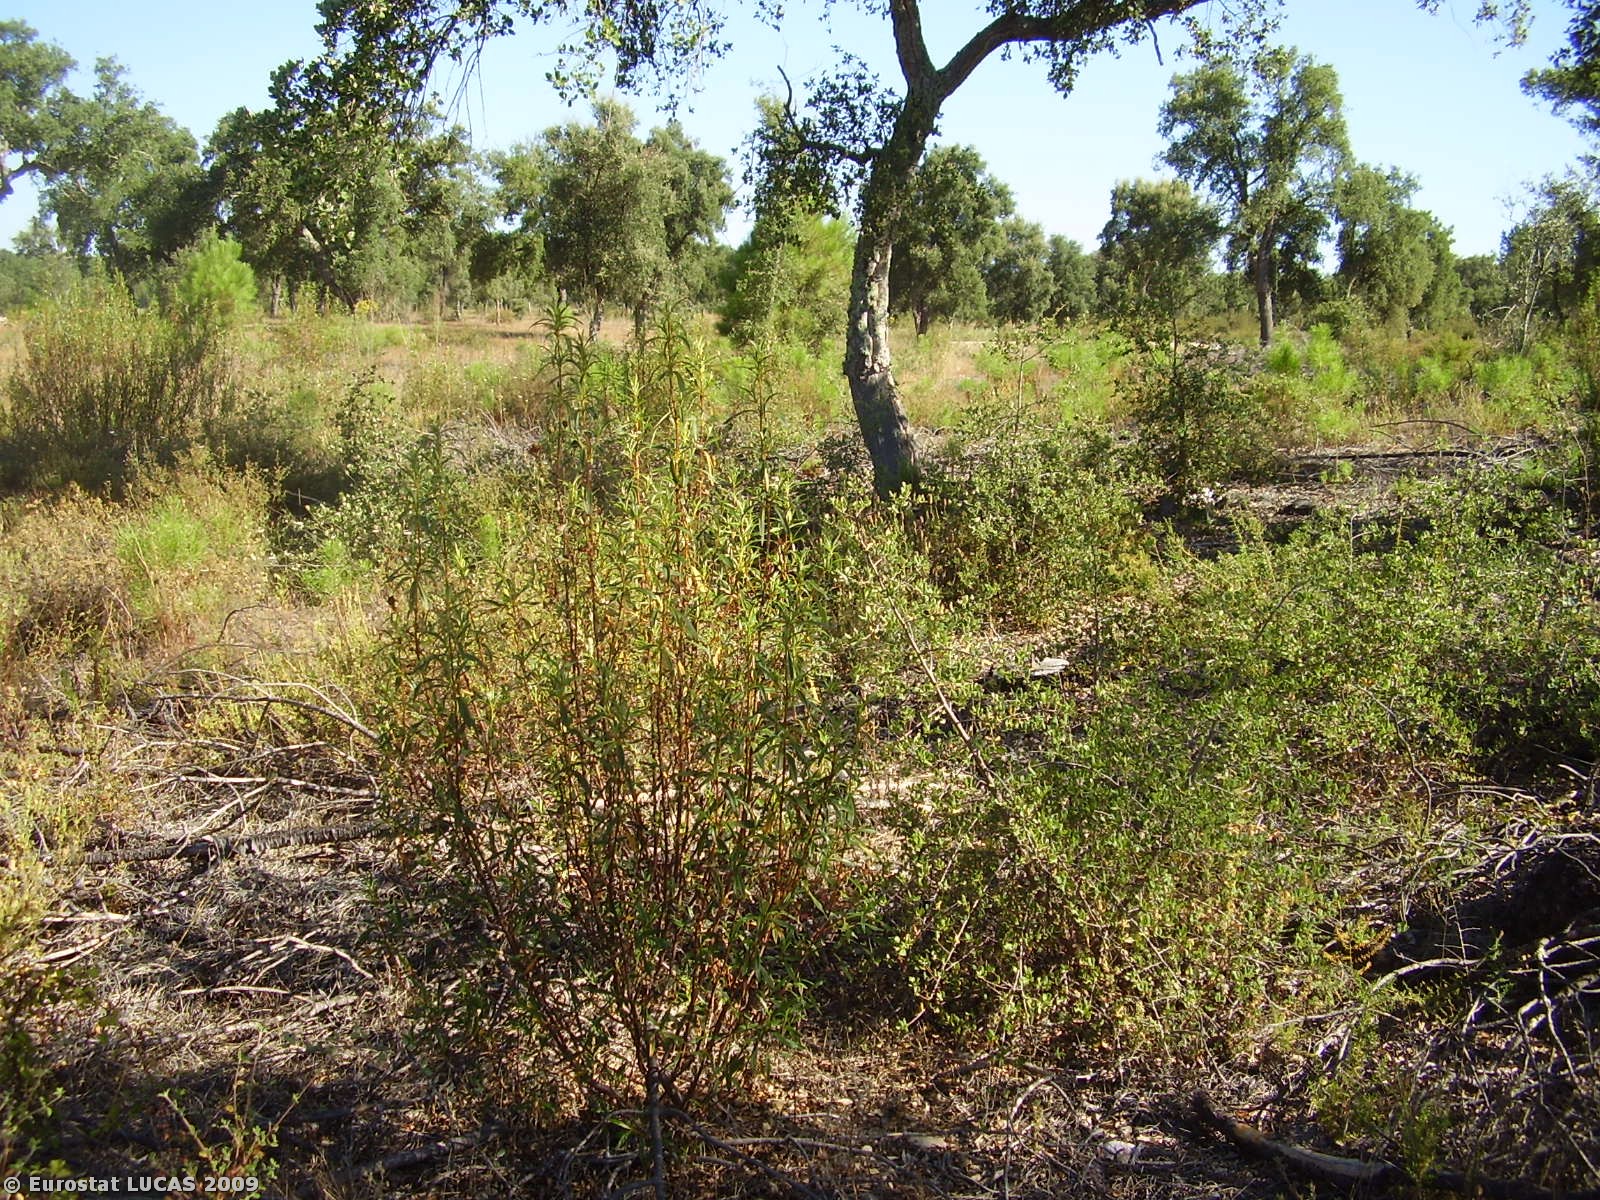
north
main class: Woodland
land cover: Broadleaved woodland
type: broadleaved evergreen forest
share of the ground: 10 - 25 %
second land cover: Shrubland with sparse tree cover
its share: 50 - 75 %
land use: Forestry
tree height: > 5 m
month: July
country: PT
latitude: 39.3483
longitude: -8.0791
